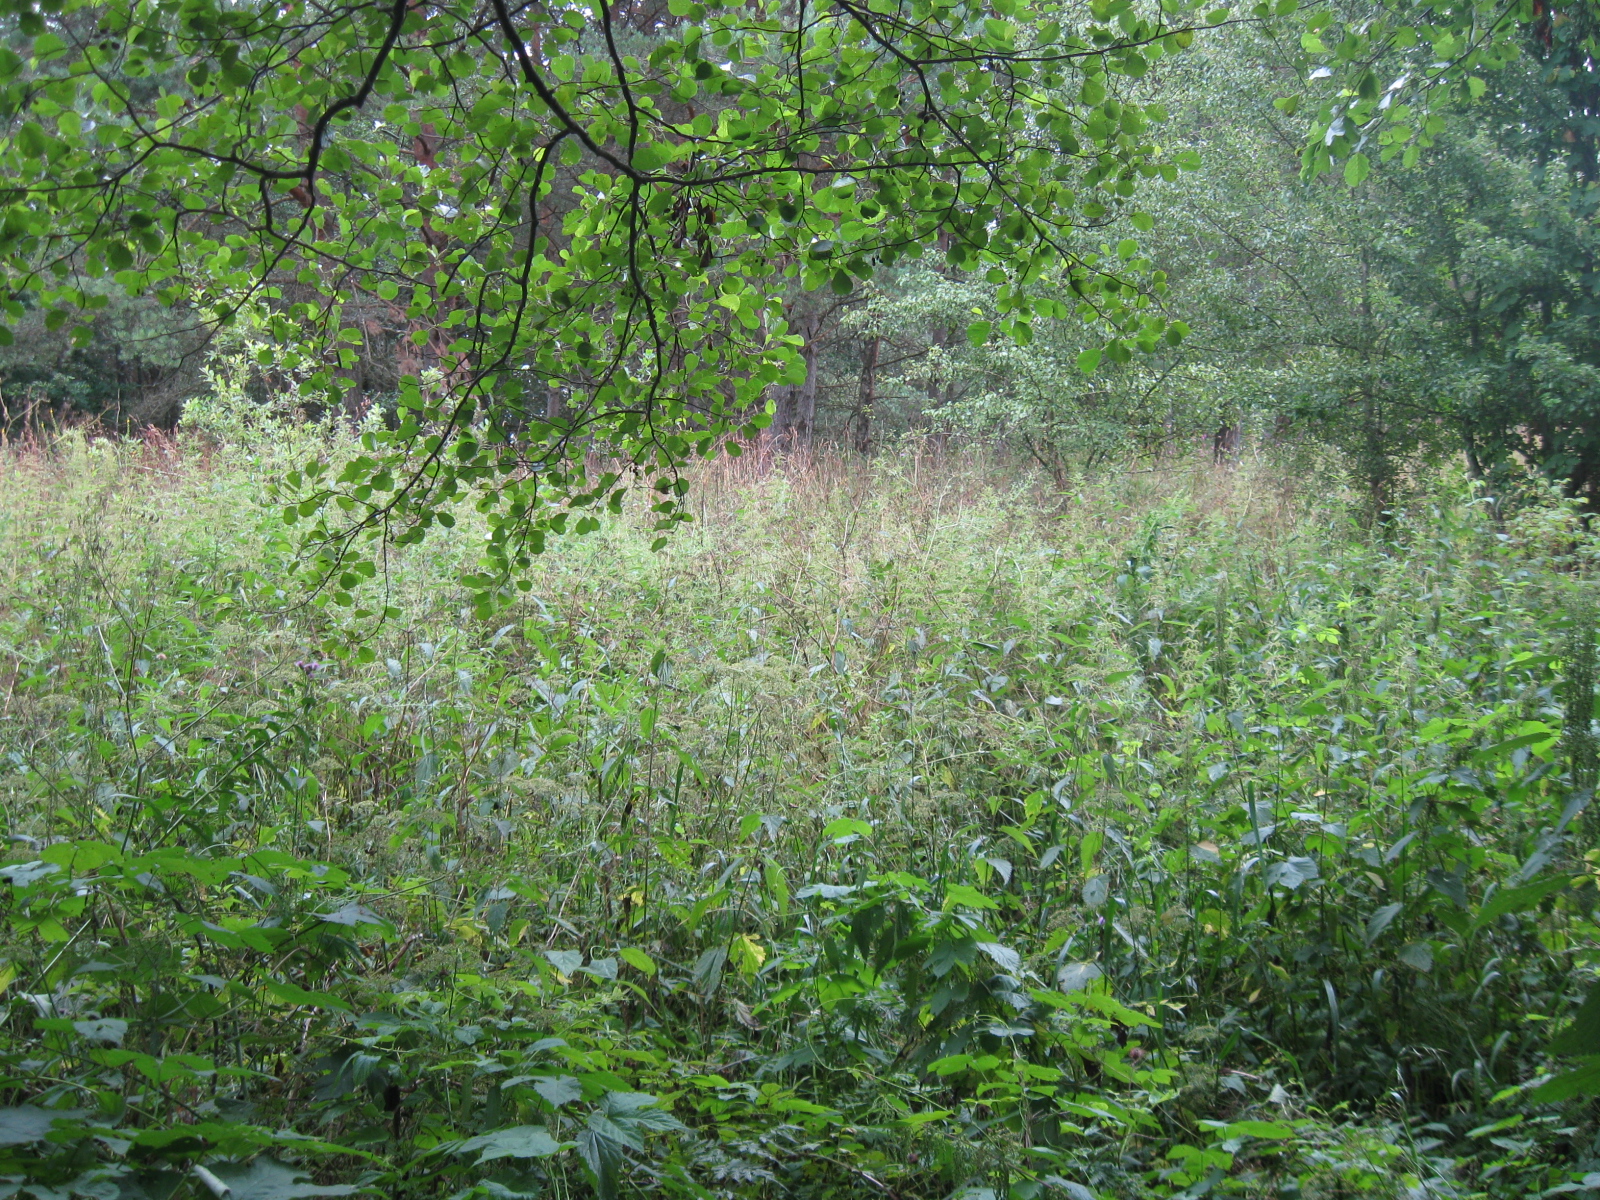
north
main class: Woodland
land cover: Broadleaved woodland
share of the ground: > 75 %
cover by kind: broadleaved forest trees 85 %, herbaceous plants 10 %, shrubs 5 %
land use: Forestry
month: July
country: LT
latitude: 54.4198
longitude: 24.3868
